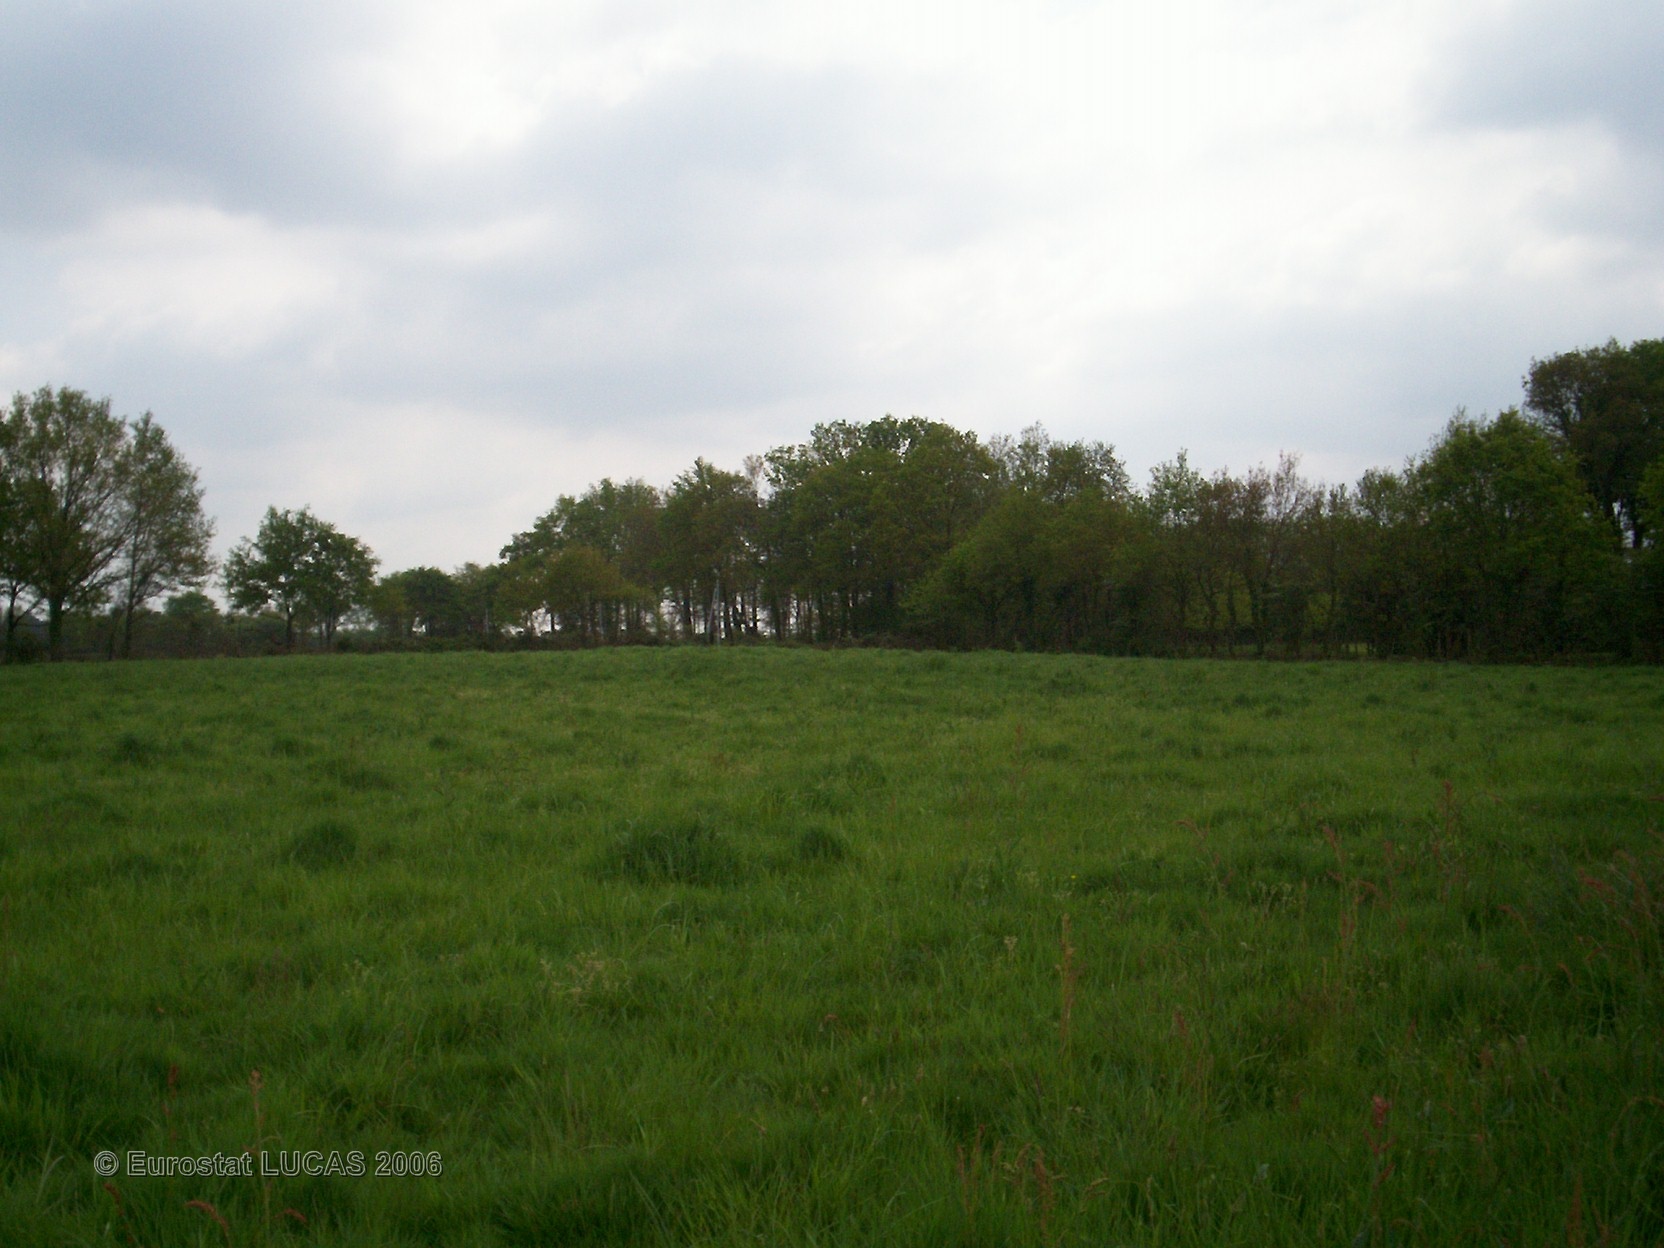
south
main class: Grassland
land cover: Grassland without tree/shrub cover
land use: Agriculture (excluding fallow land and kitchen gardens)
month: May
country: FR
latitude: 47.5213
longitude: -2.2313
